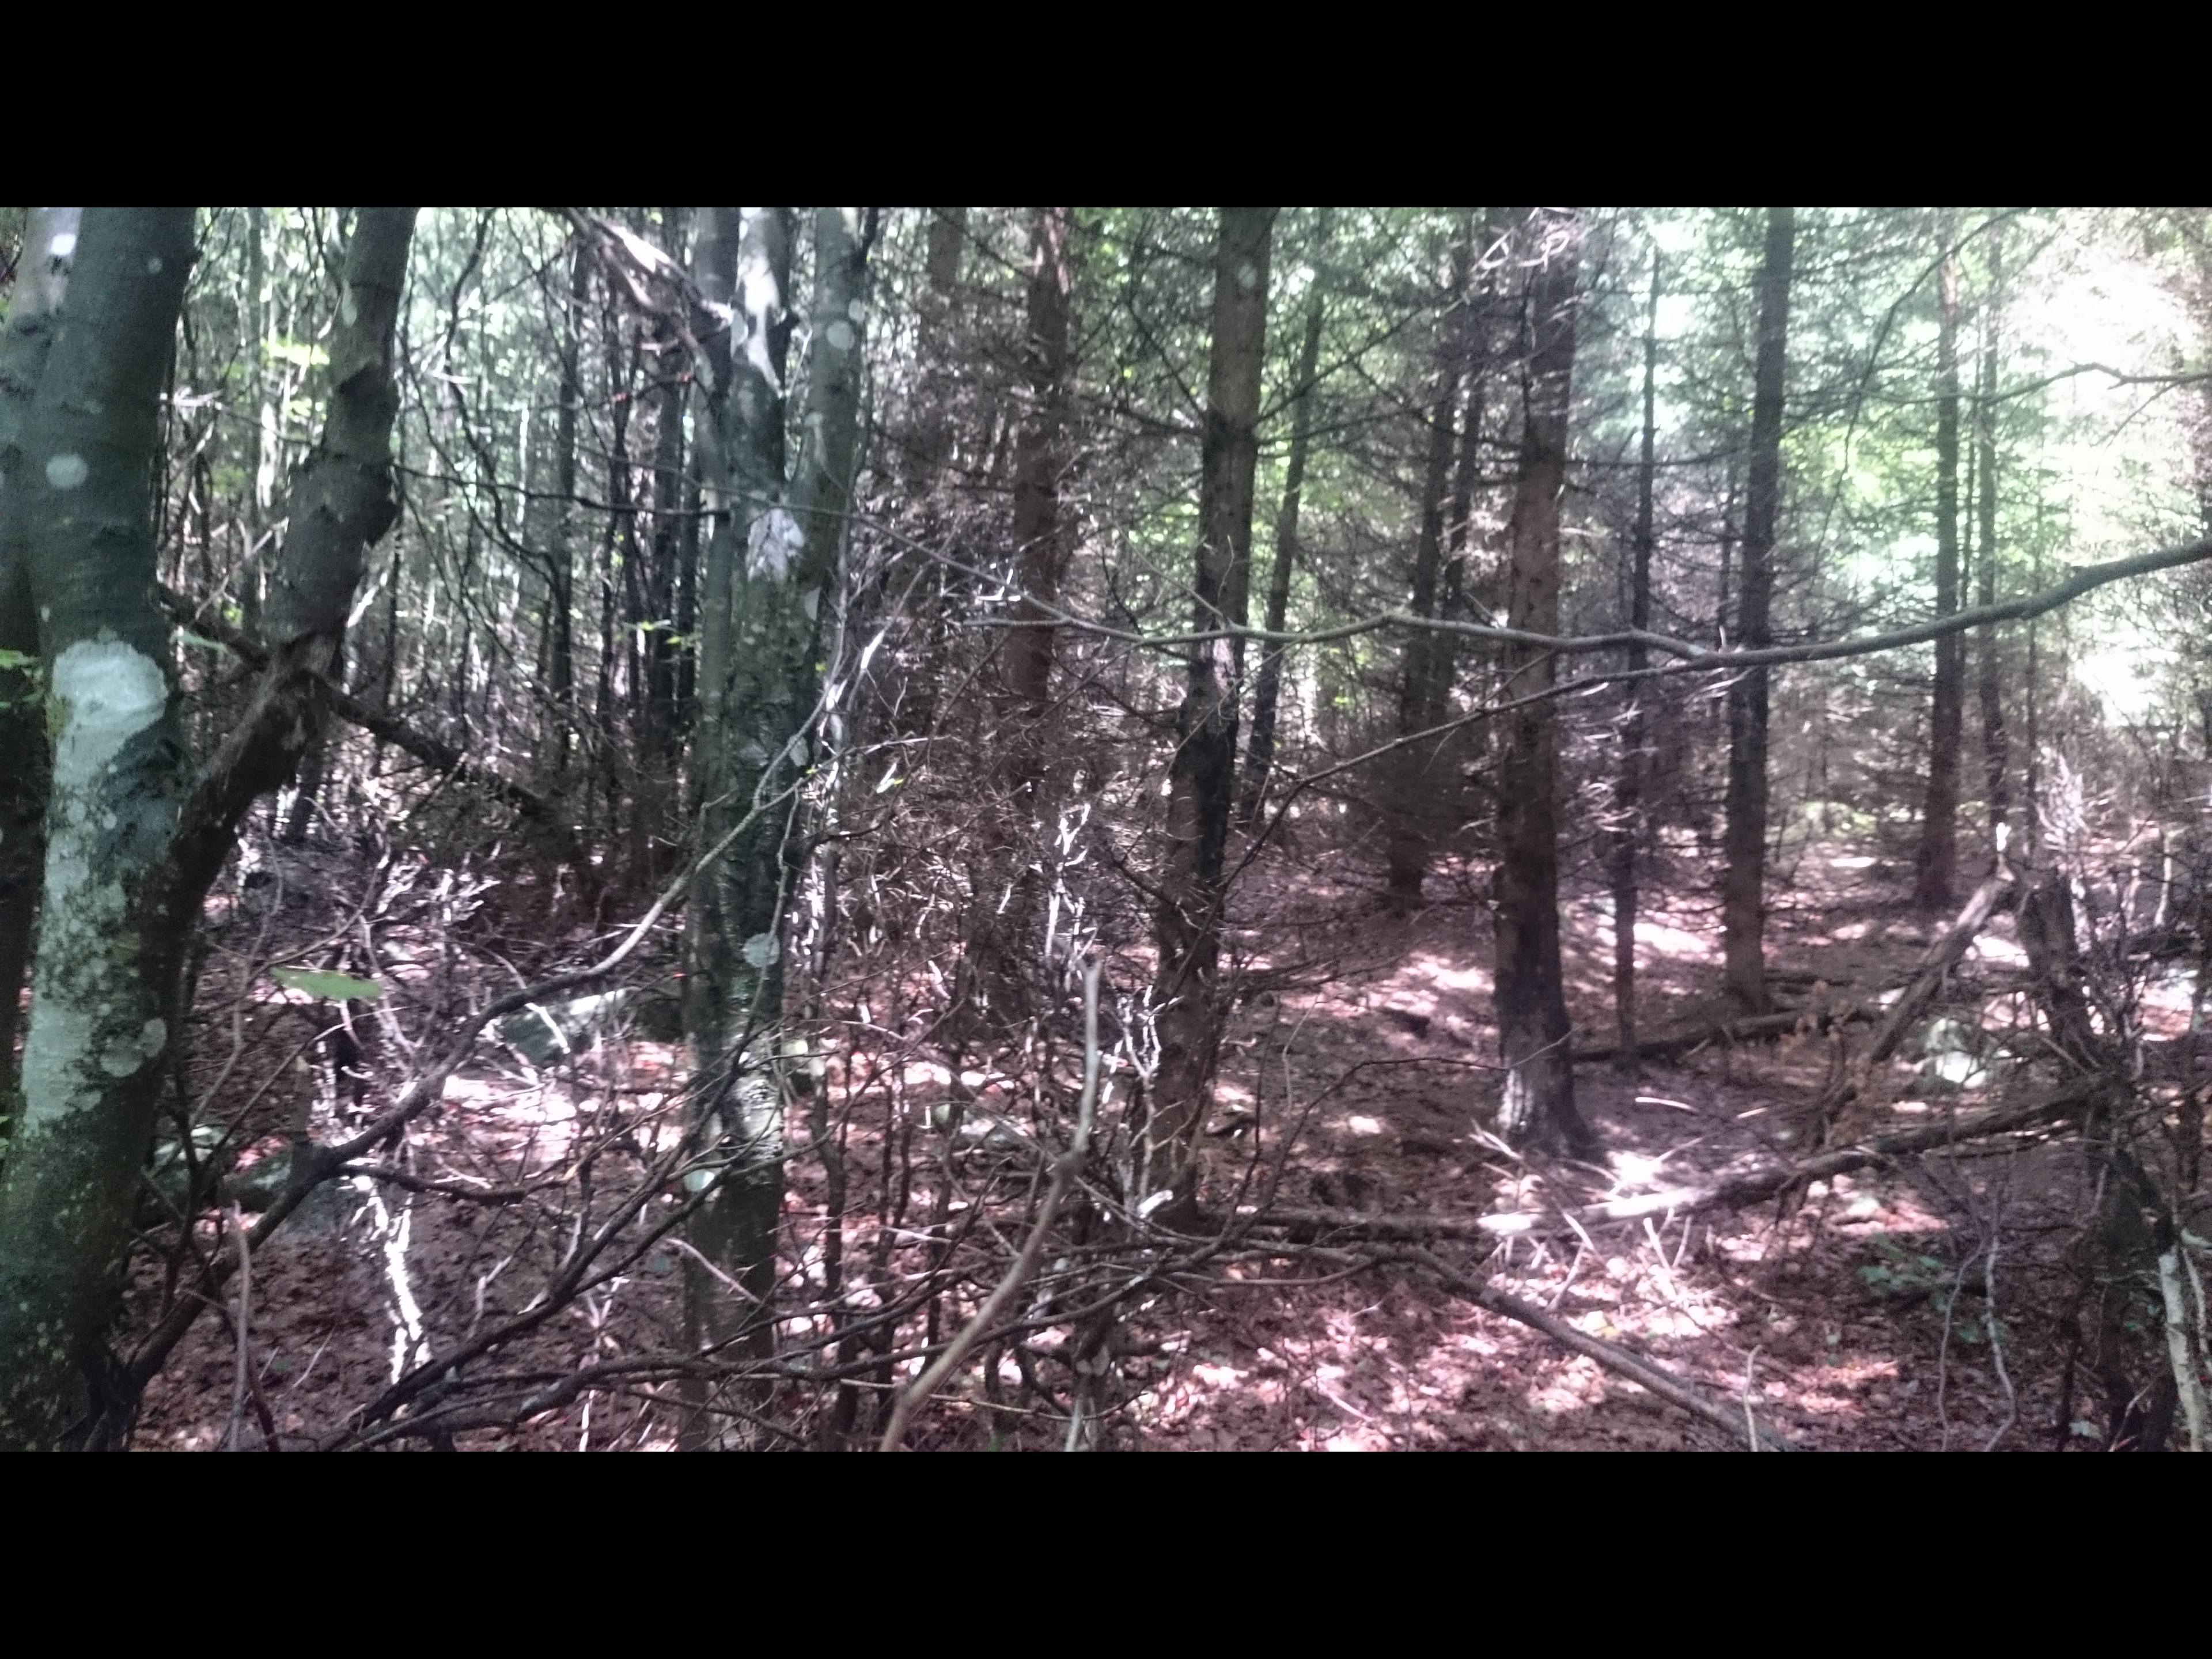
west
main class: Woodland
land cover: Spruce dominated mixed woodland
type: hemiboreal forest and nemoral coniferous forest and mixed broadleaved-coniferous forest
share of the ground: > 75 %
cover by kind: coniferous forest trees 65 %, broadleaved forest trees 30 %, unconsolidated bare surface 5 %
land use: Forestry
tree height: > 5 m
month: June
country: AT
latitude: 48.6444
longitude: 14.7380
